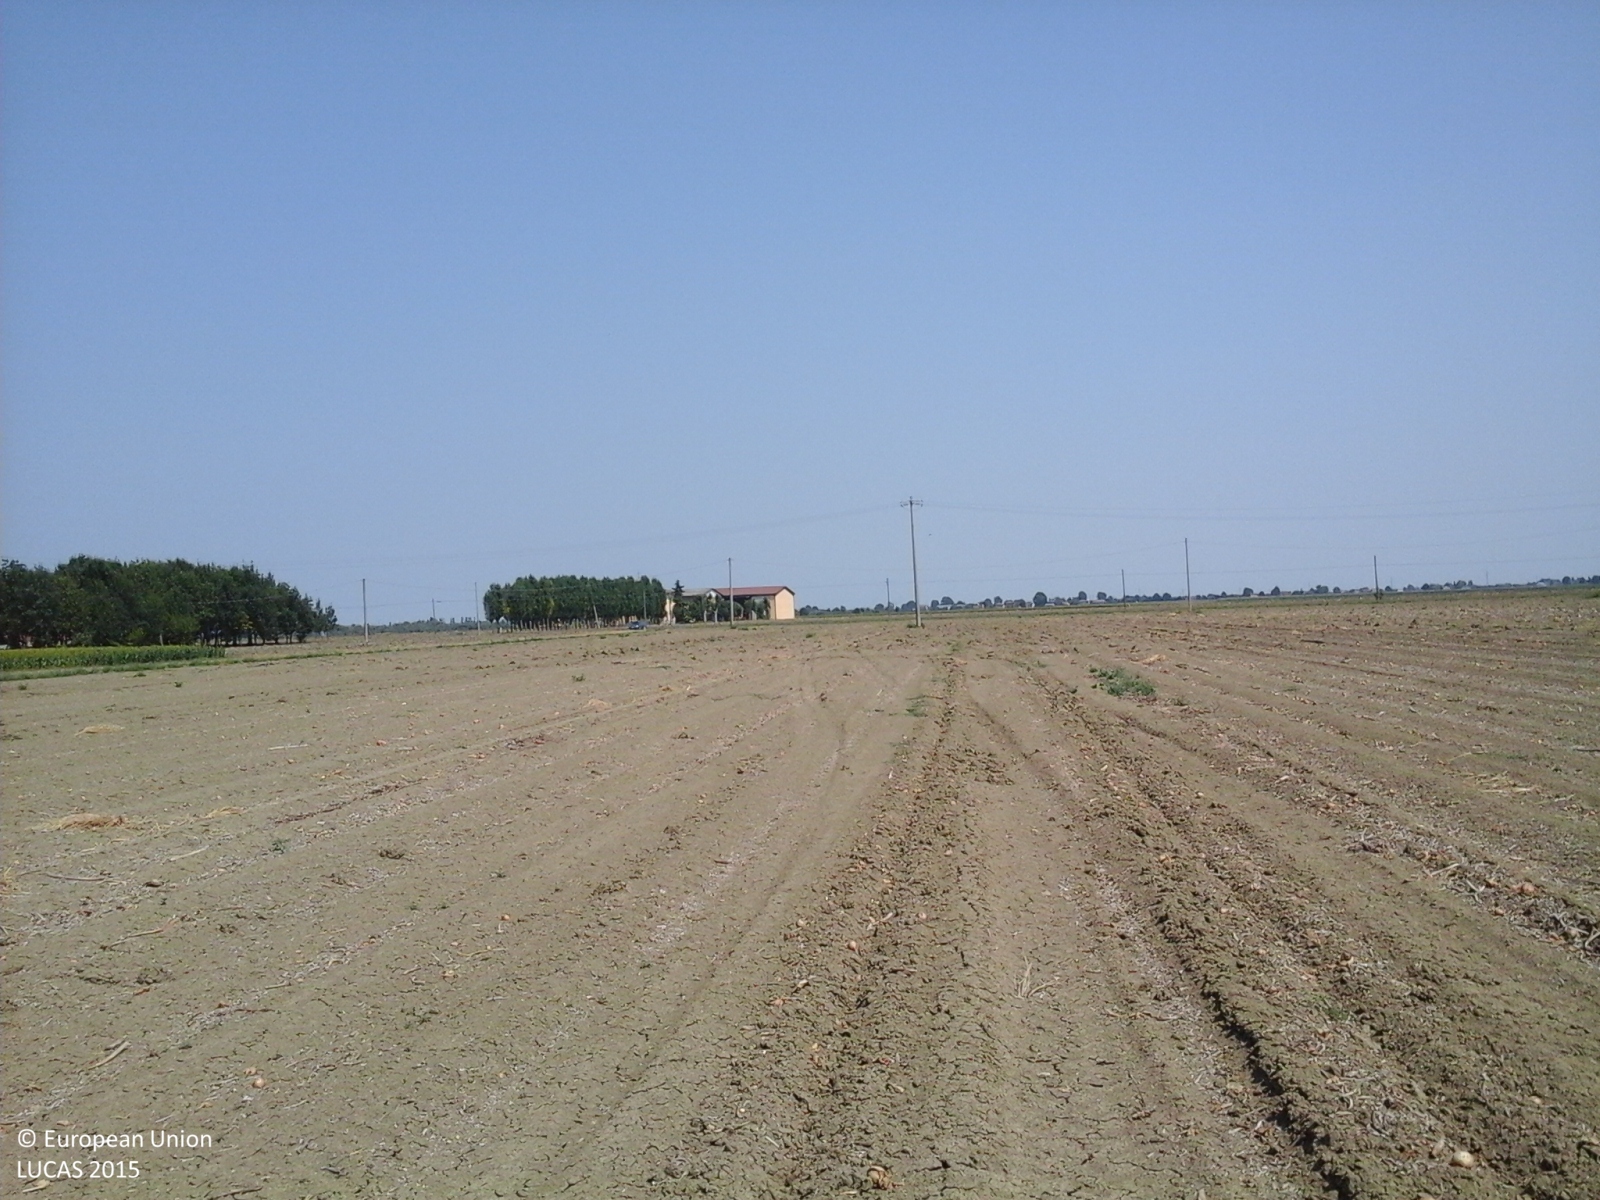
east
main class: Cropland
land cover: Other root crops
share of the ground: > 75 %
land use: Agriculture (excluding fallow land and kitchen gardens)
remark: Harvested field
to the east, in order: Other root crops; Electric lines; Other root crops; Grass margins; Ditches and canals; Grass margins; Tracks; Common wheat; Grass margins; Ditches and canals; Grass margins; Tracks; Grass margins; Ditches and canals; Common wheat; Electric lines; Common wheat
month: July
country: IT
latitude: 44.4991
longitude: 11.6942
